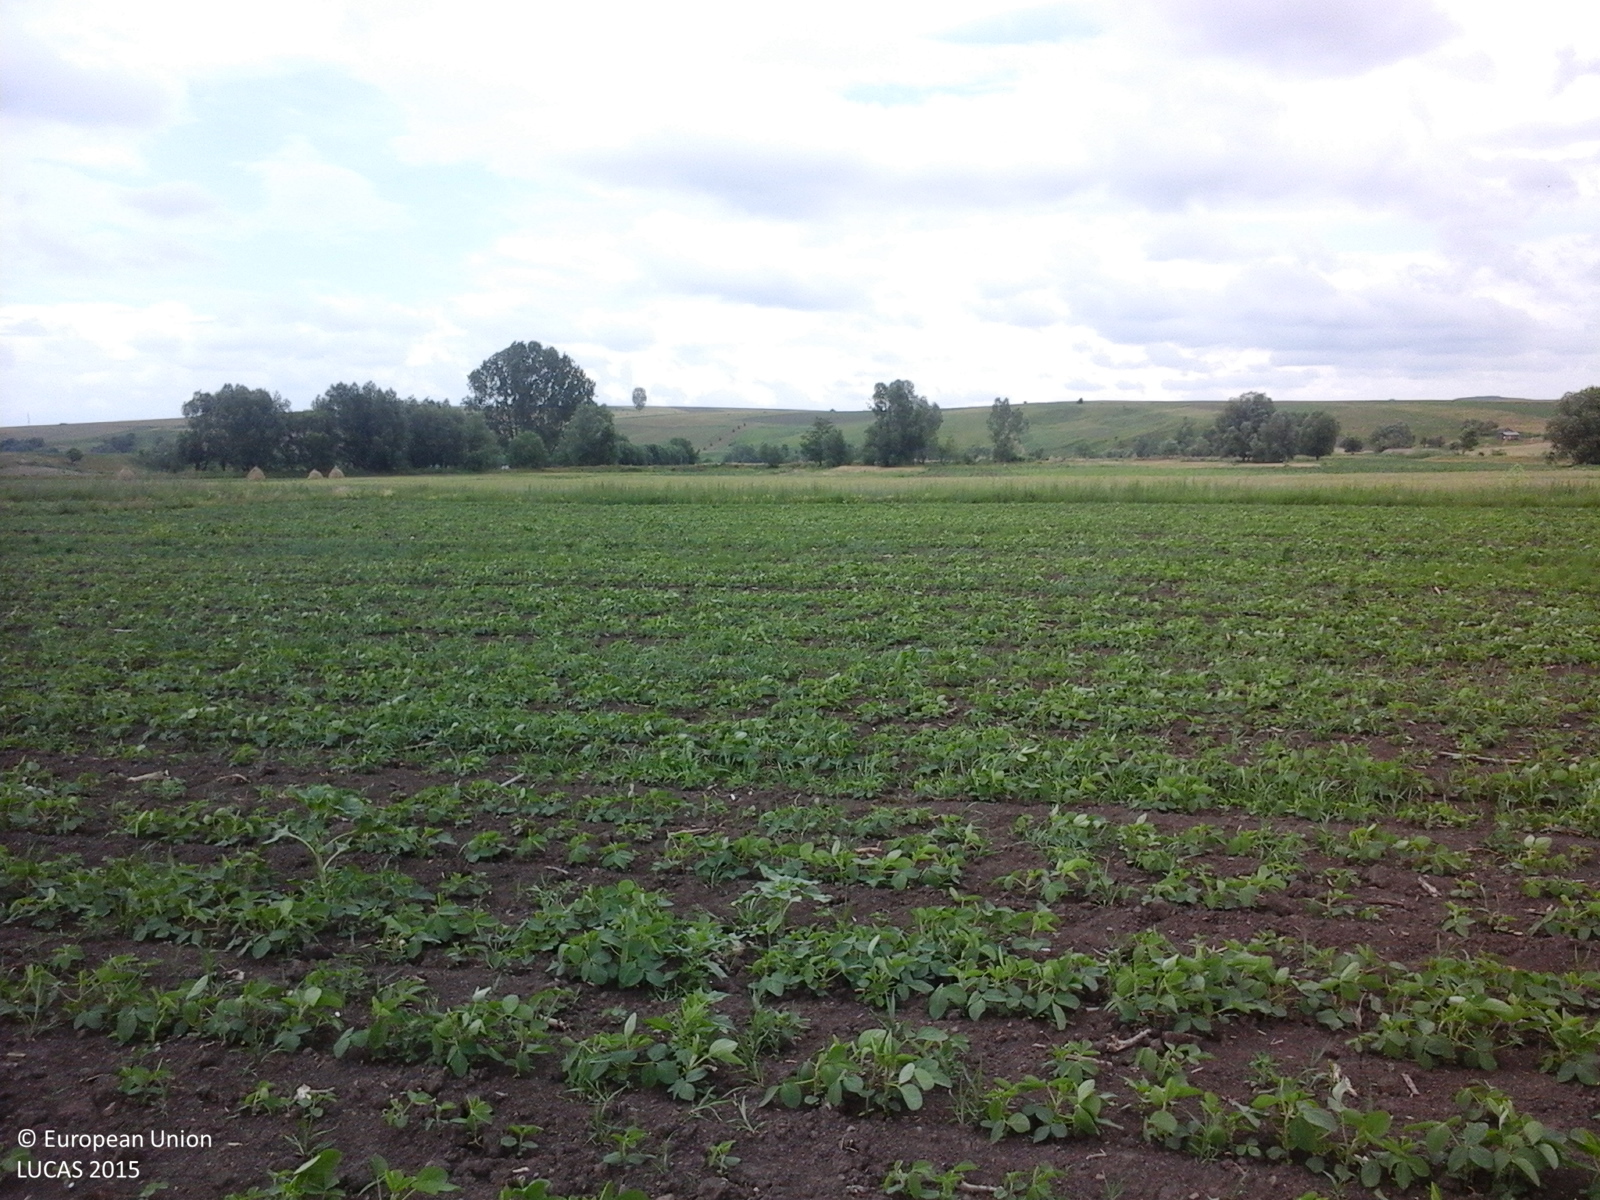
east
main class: Cropland
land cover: Soya
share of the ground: > 75 %
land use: Agriculture (excluding fallow land and kitchen gardens)
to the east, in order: Soya; Common wheat; Lucerne; Tracks; Common wheat; Lucerne
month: May
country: RO
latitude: 47.1402
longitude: 26.3400
